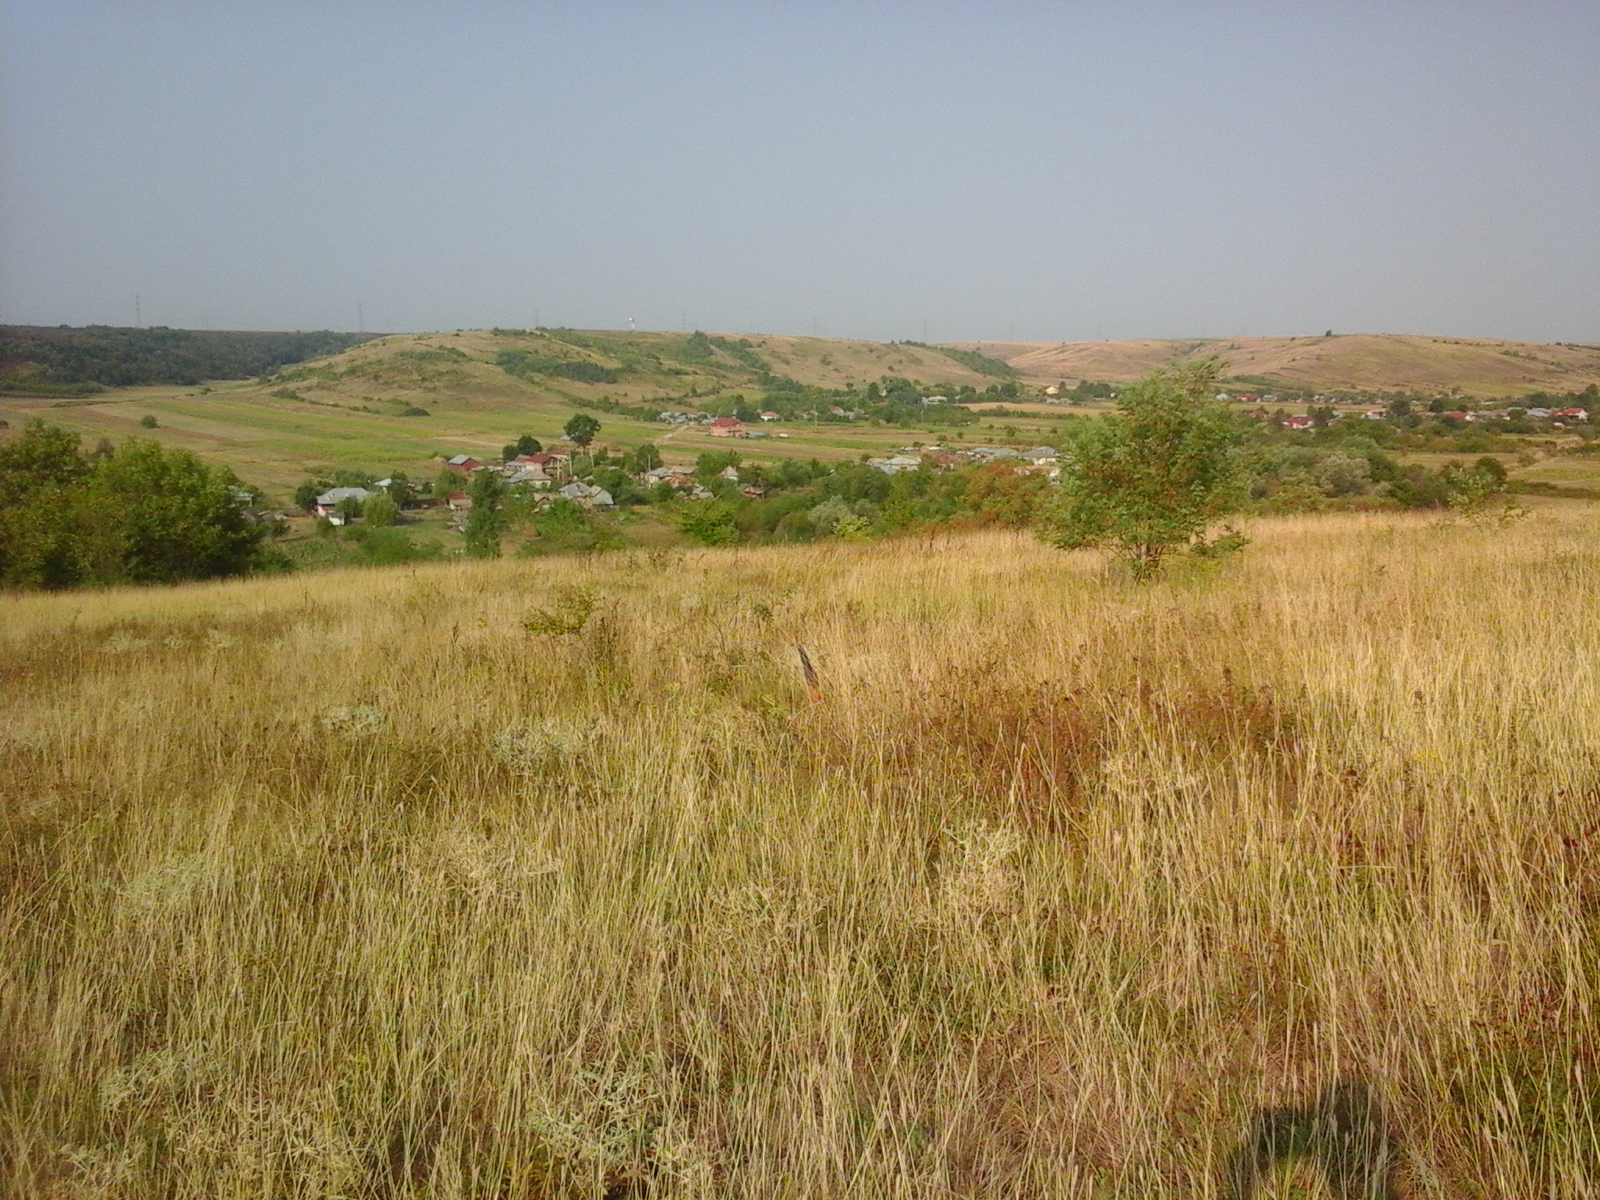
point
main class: Grassland
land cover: Grassland with sparse tree/shrub cover
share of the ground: > 75 %
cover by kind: herbaceous plants 90 %, broadleaved forest trees 5 %, shrubs 5 %
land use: Fallow land
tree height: < 5 m
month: August
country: RO
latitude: 44.5120
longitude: 23.8592
